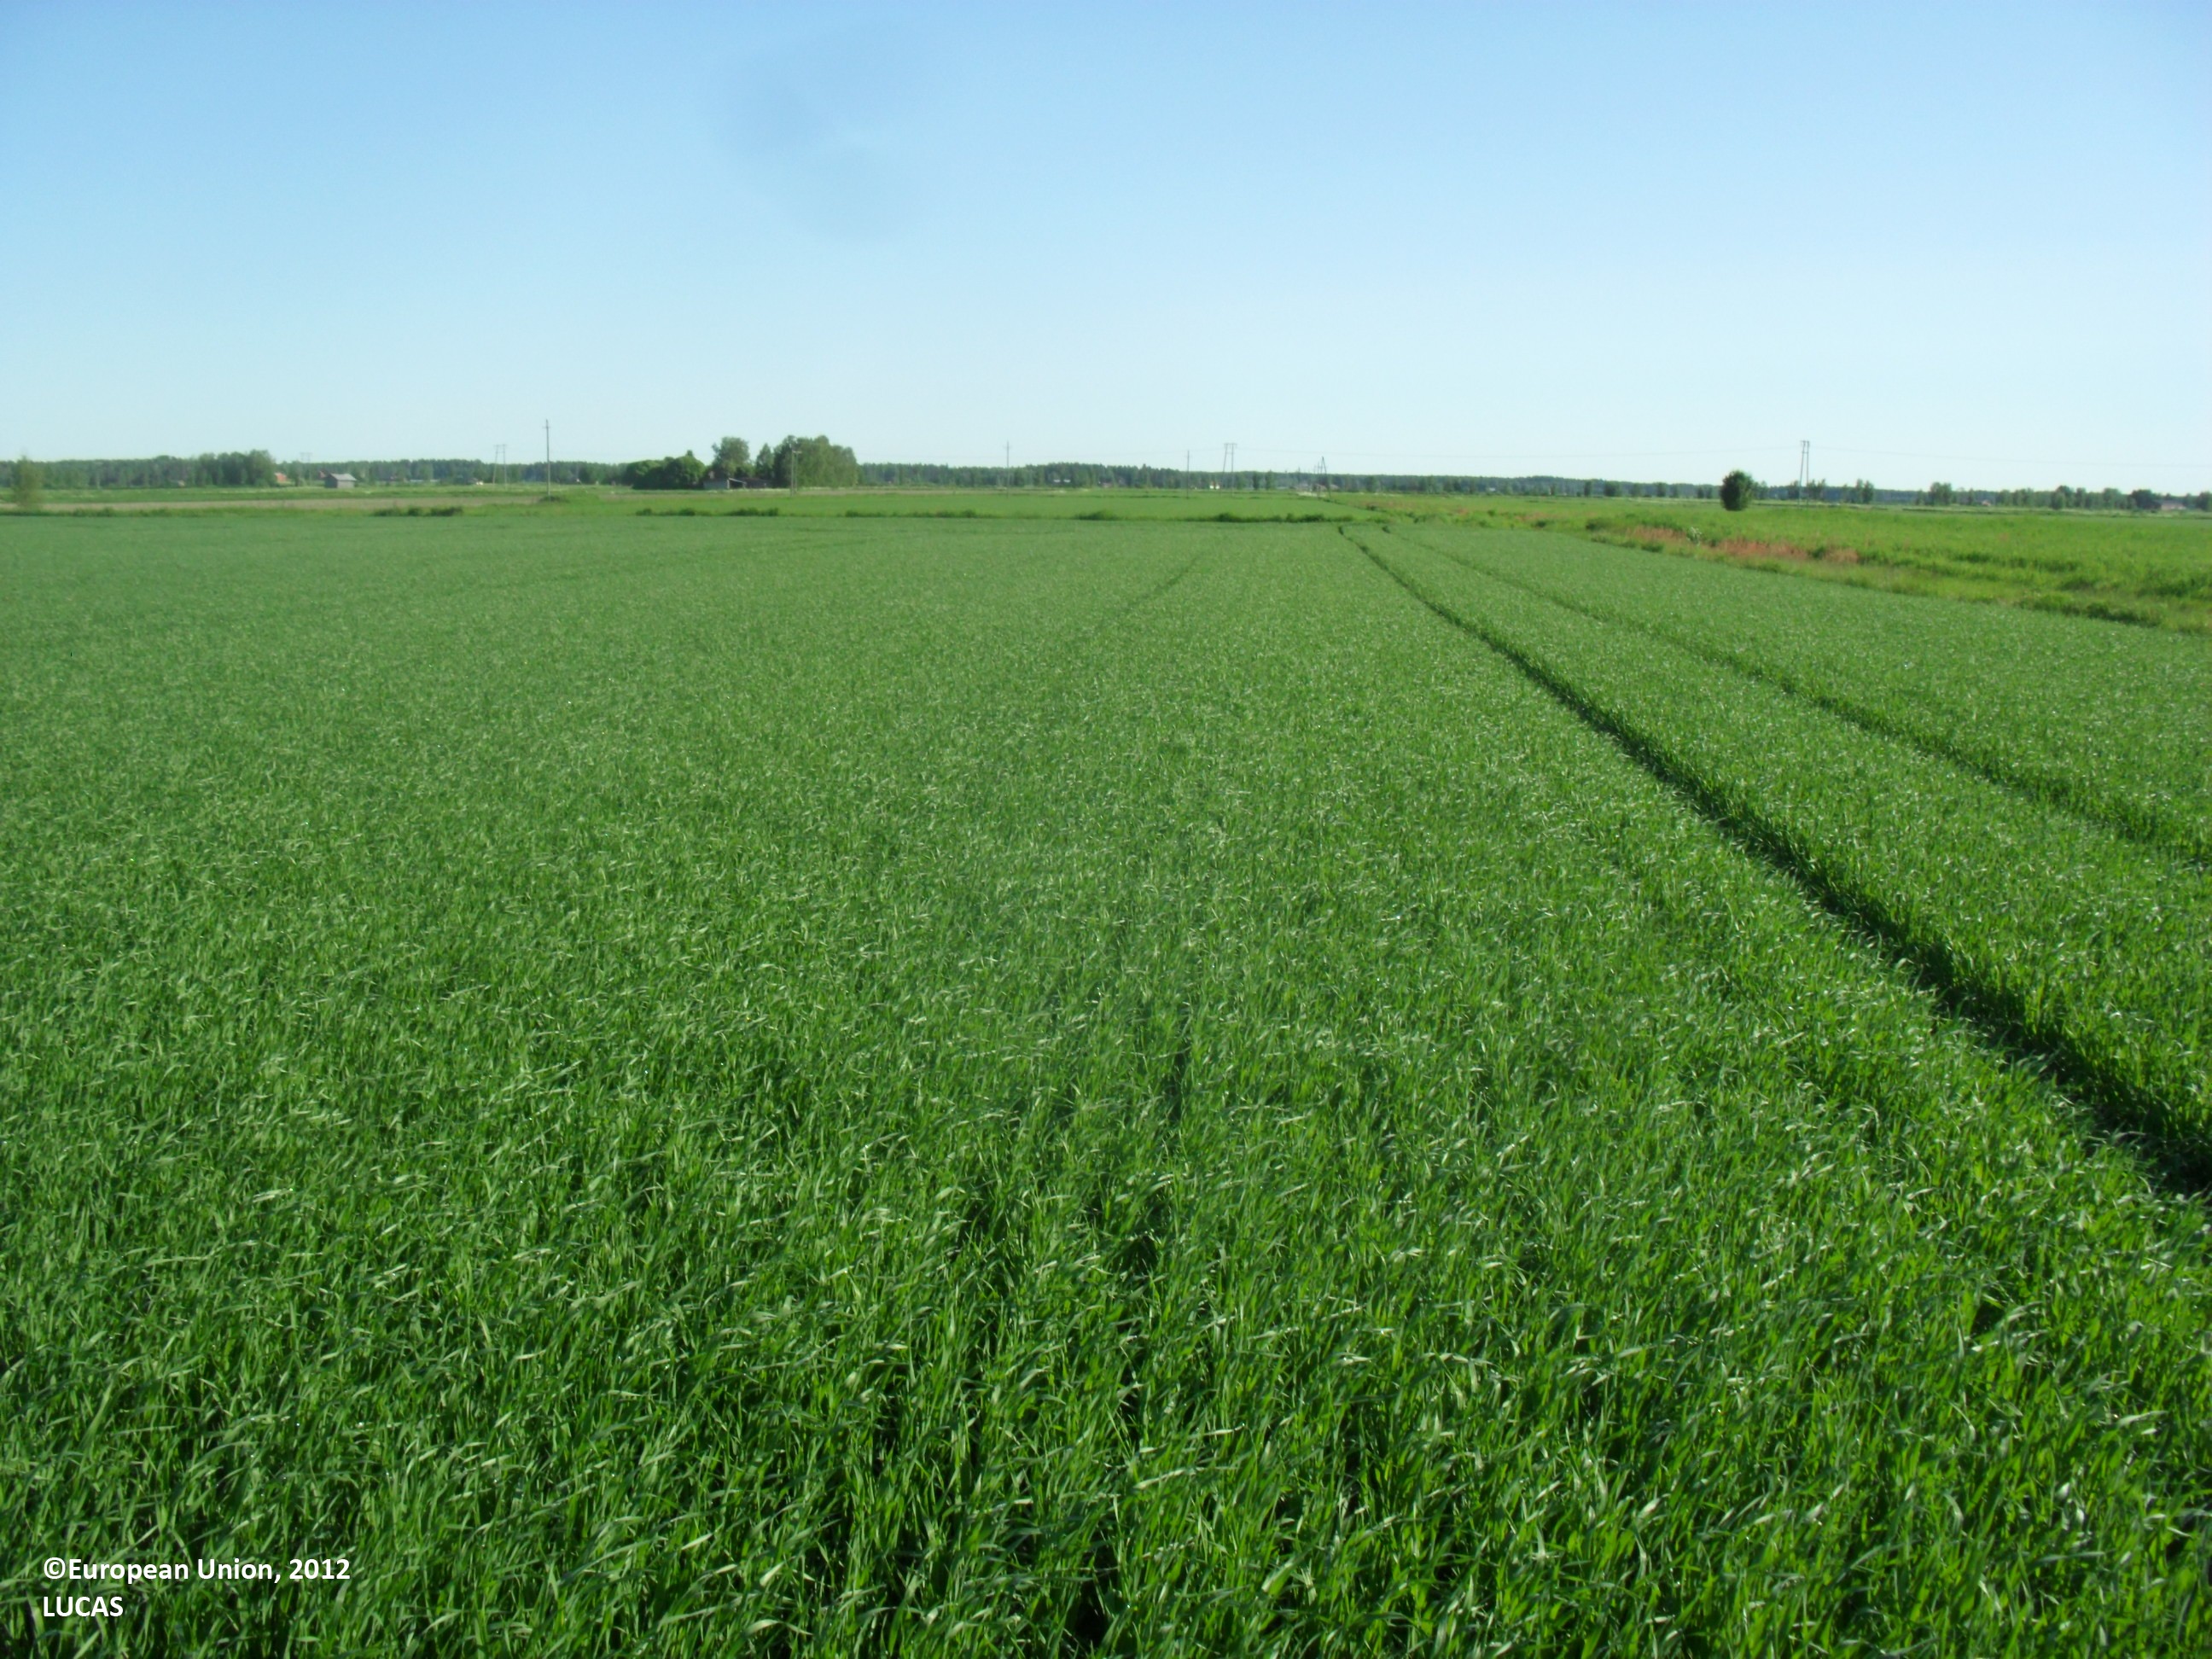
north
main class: Cropland
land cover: Oats
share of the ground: > 75 %
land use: Agriculture (excluding fallow land and kitchen gardens)
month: June
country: FI
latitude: 63.0768
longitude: 22.9442
